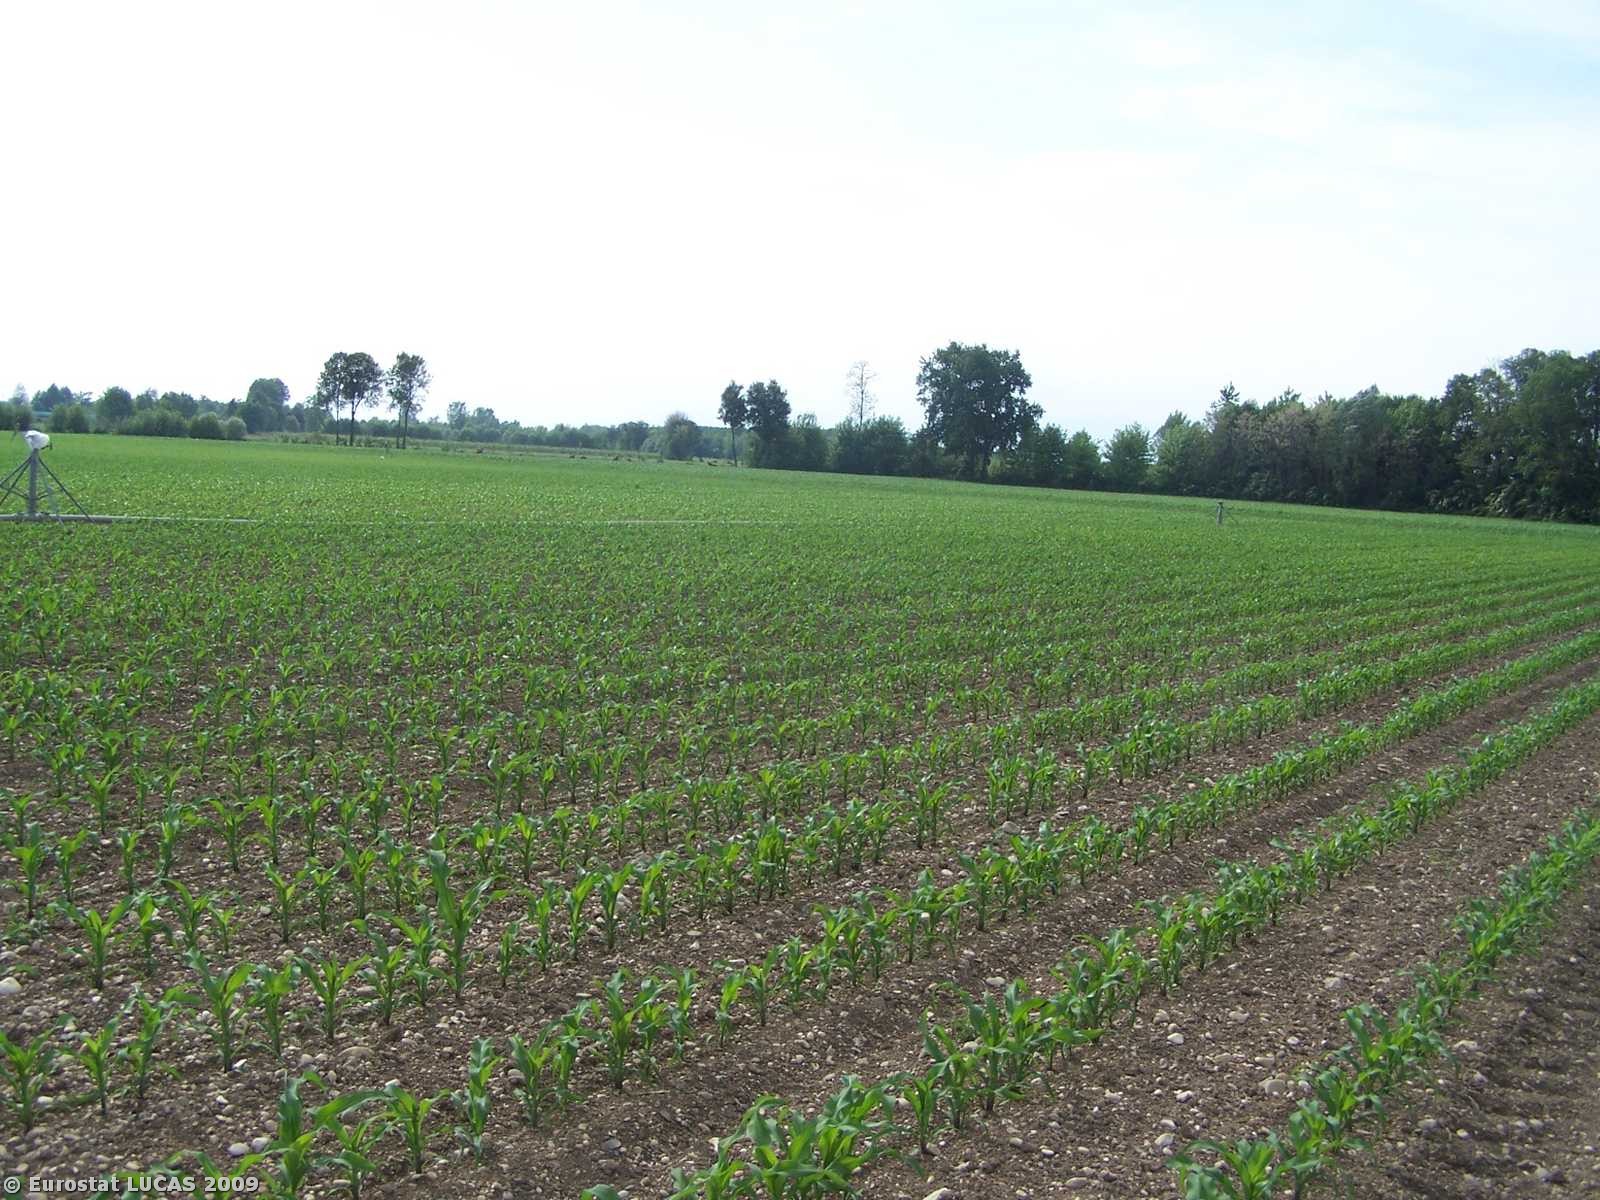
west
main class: Cropland
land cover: Maize
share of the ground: 25 - 50 %
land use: Agriculture (excluding fallow land and kitchen gardens)
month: May
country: IT
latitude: 45.9133
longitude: 12.9745
